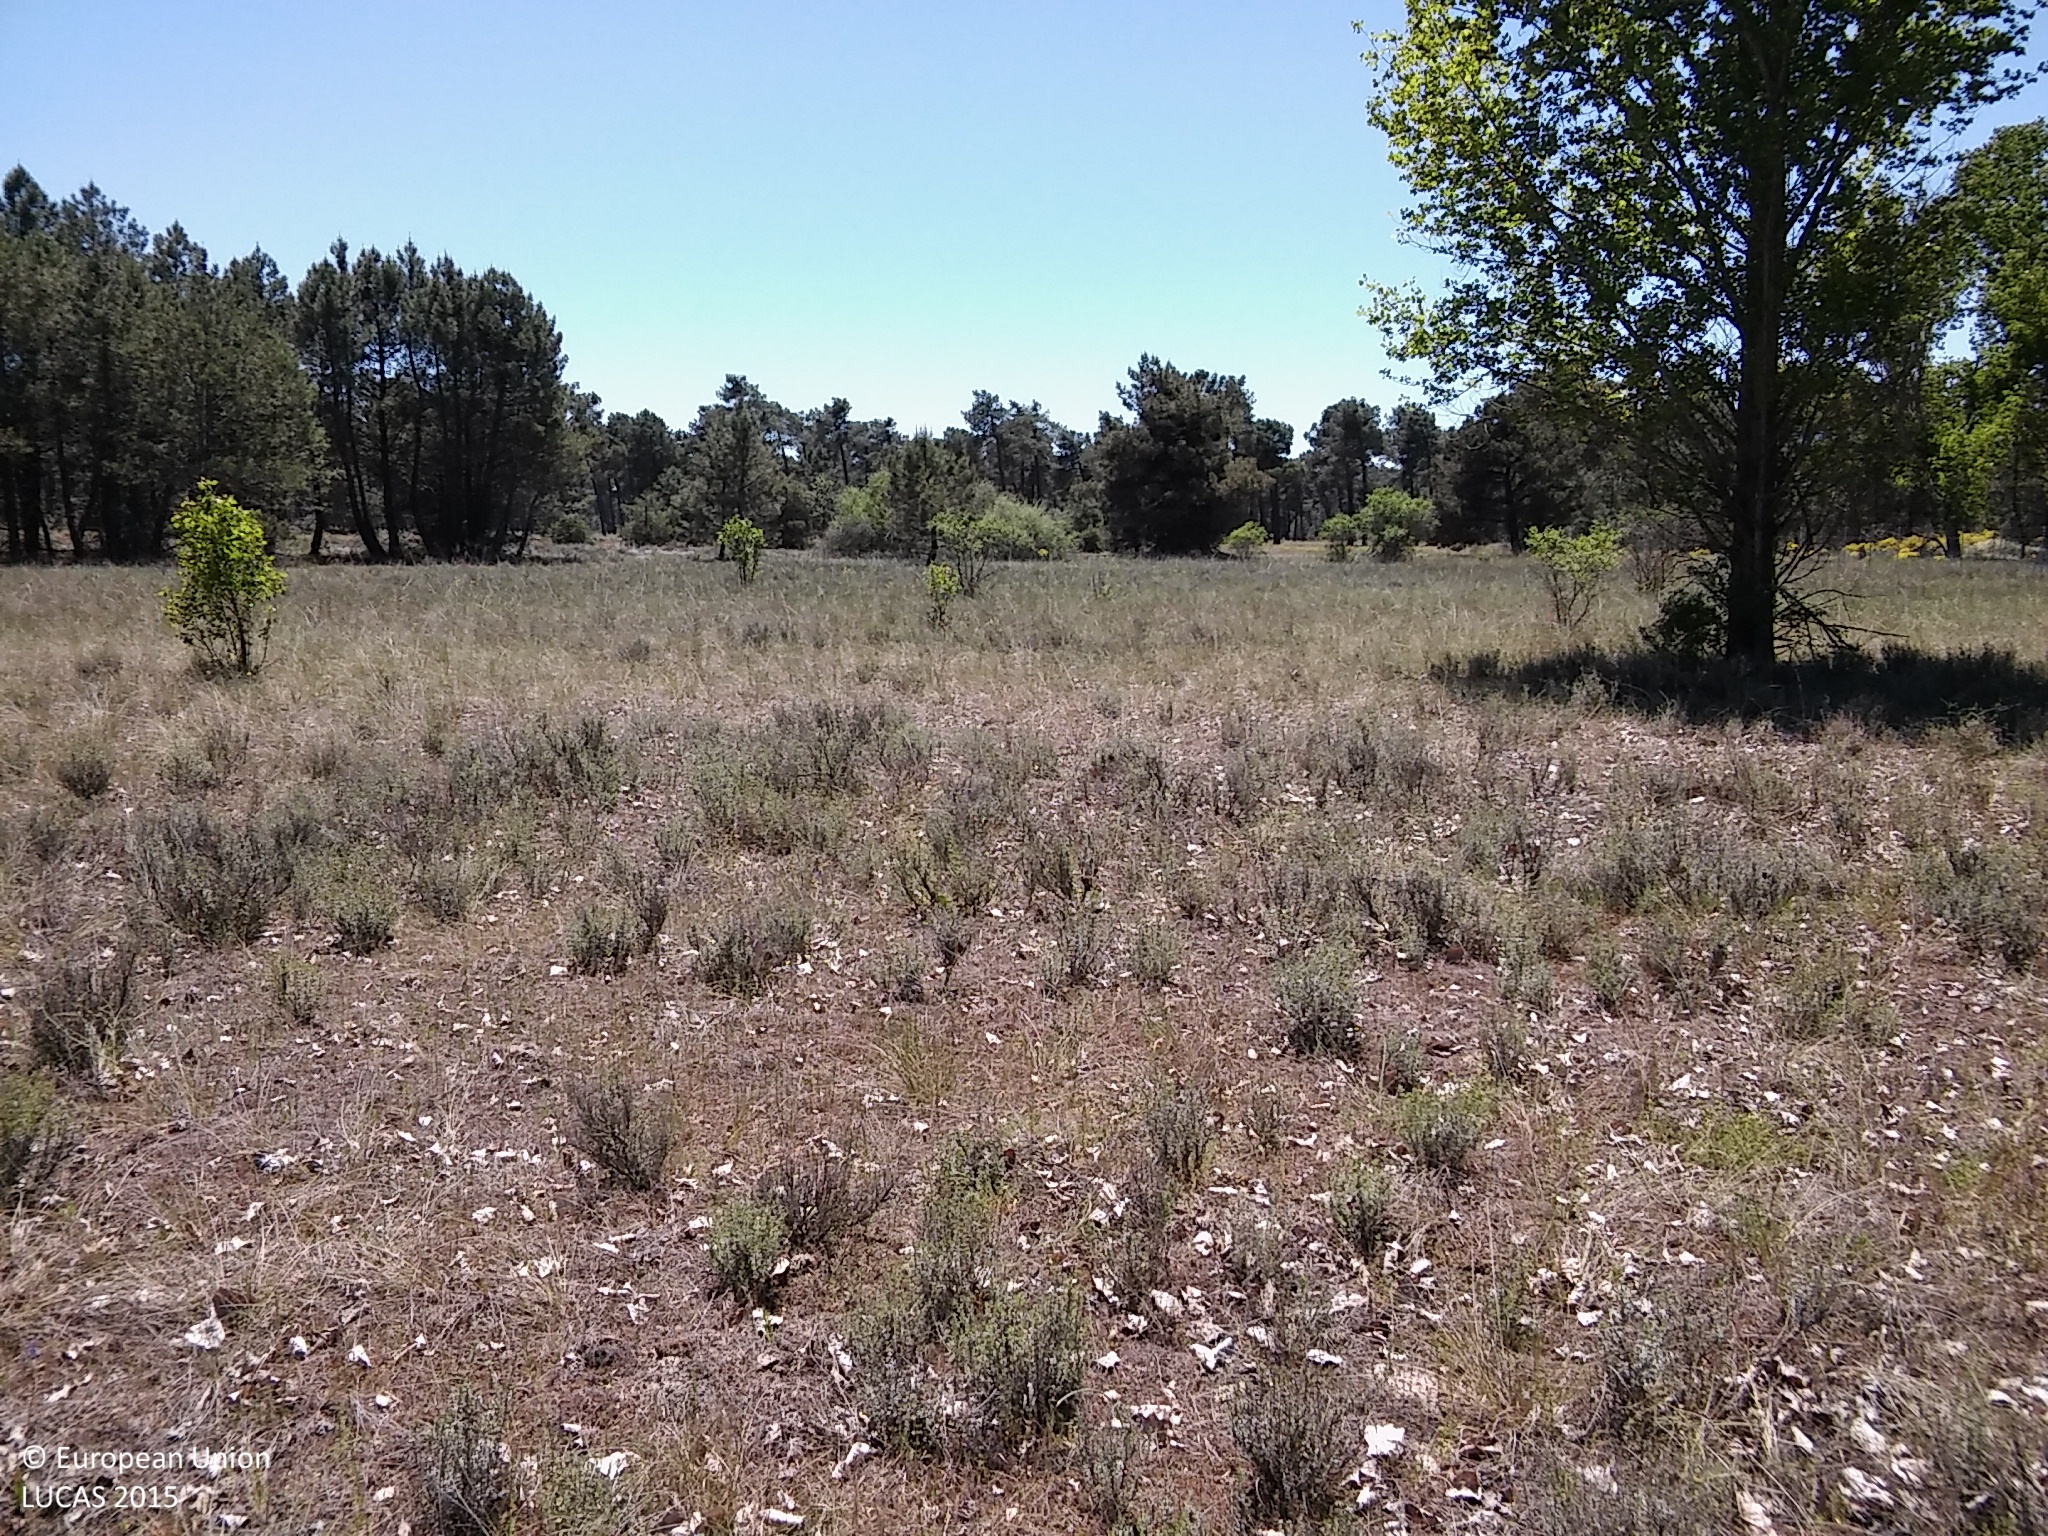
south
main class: Grassland
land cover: Grassland without tree/shrub cover
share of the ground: > 75 %
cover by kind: herbaceous plants 95 %, shrubs 5 %
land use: Semi-natural and natural areas not in use
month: May
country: ES
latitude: 41.2269
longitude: -4.0702
